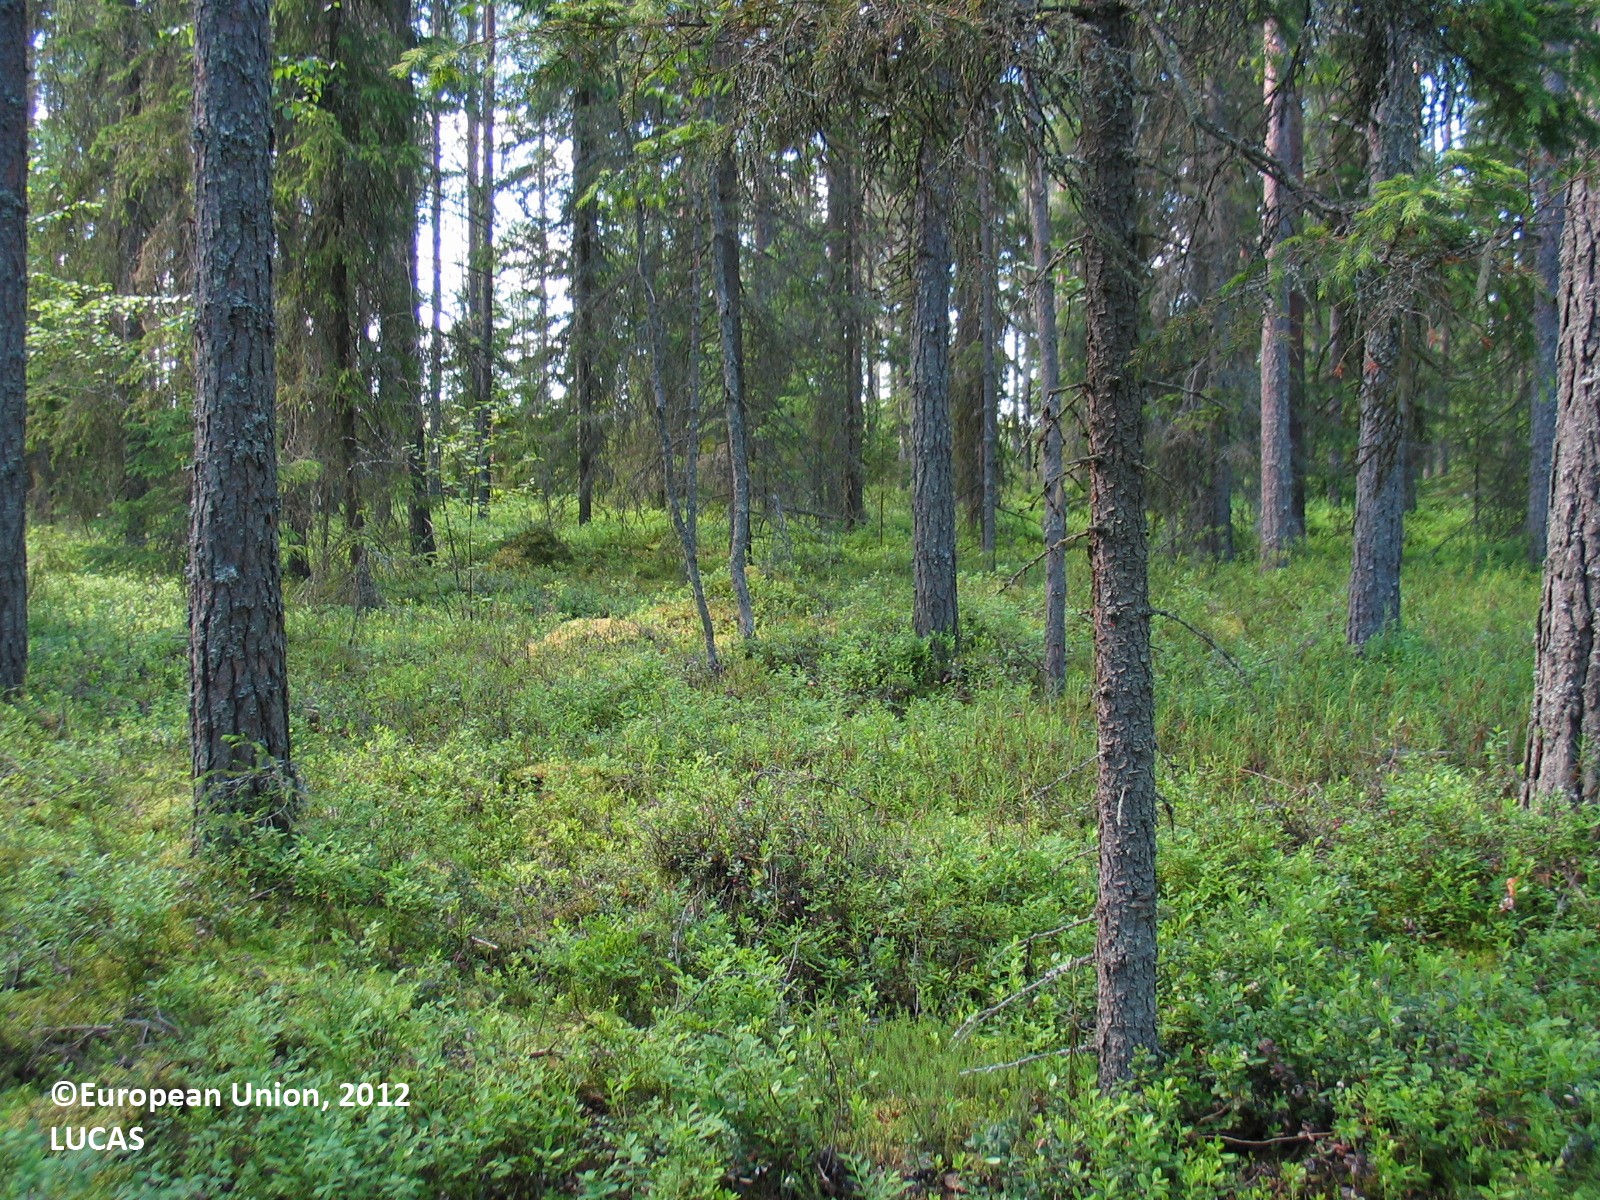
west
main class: Woodland
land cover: Pine dominated coniferous woodland
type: mire and swamp forests
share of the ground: 50 - 75 %
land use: Forestry
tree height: > 5 m
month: July
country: FI
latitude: 64.7082
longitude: 26.5388
